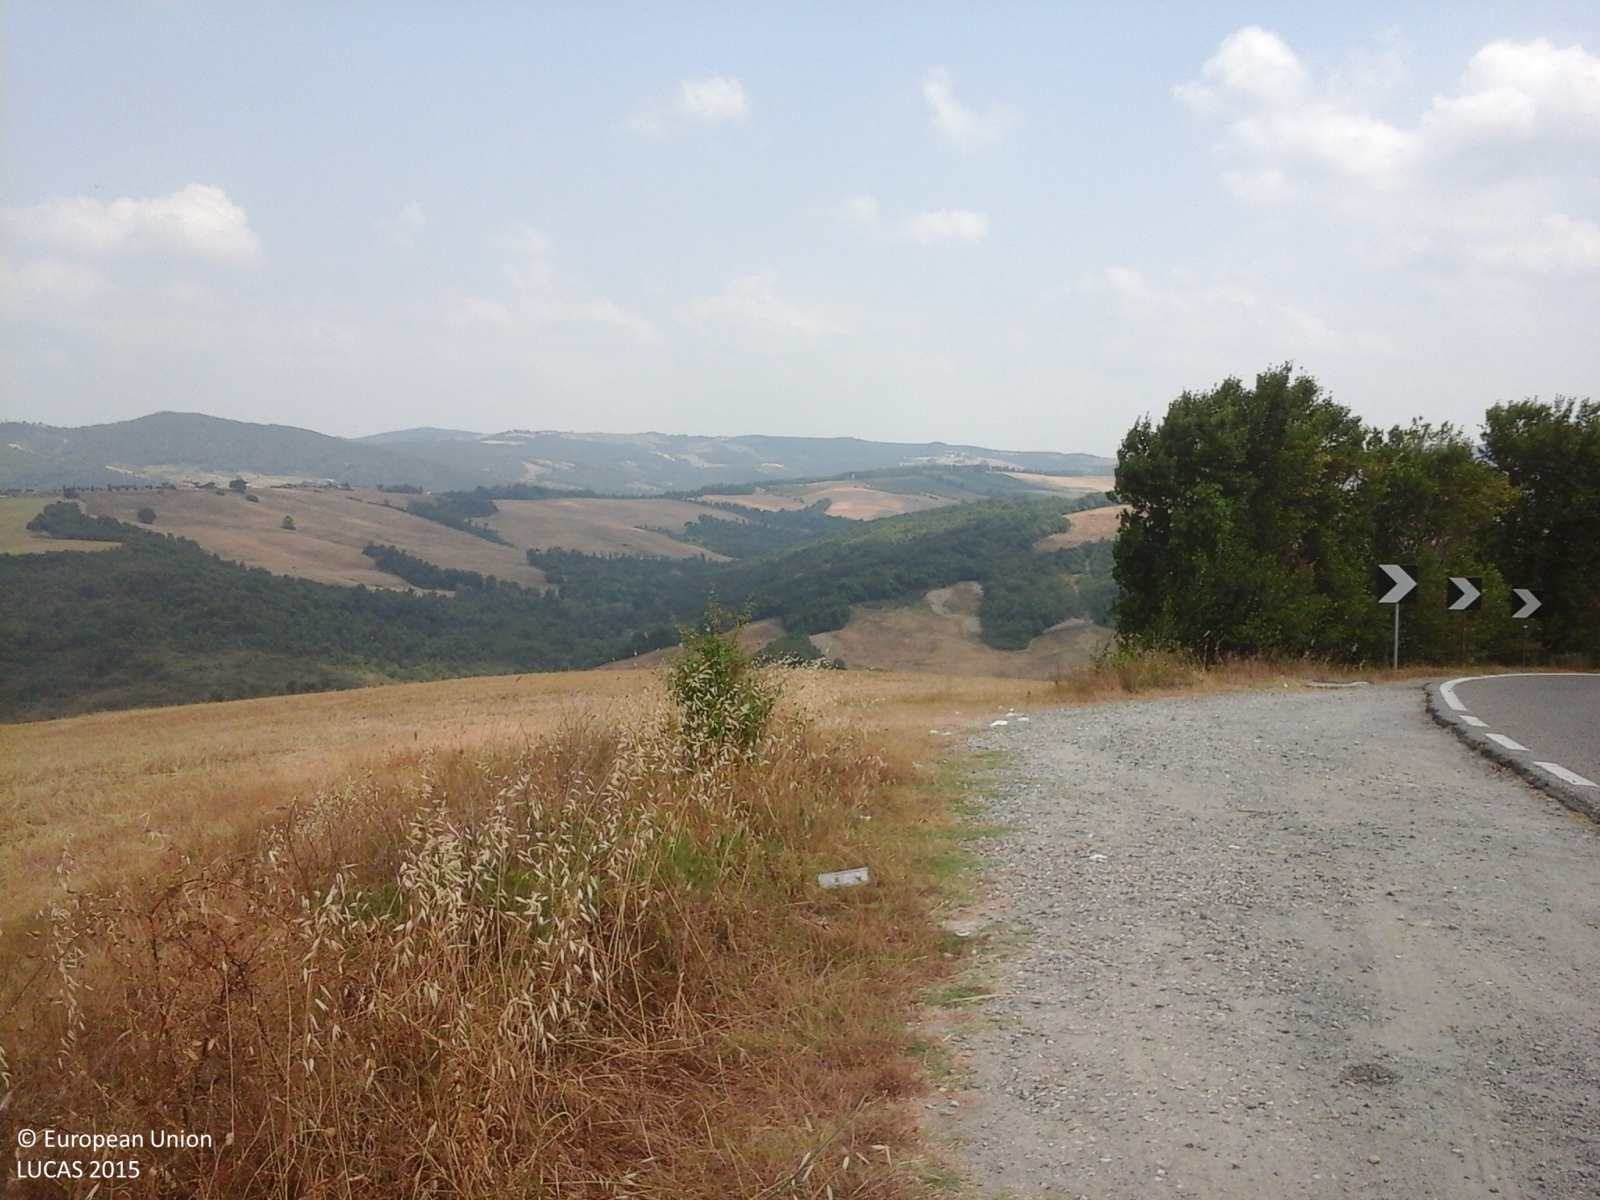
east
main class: Woodland
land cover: Broadleaved woodland
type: thermophilous deciduous forest
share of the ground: > 75 %
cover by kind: broadleaved forest trees 100 %
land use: Forestry
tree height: > 5 m
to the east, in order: Broadleaved woodland; Oats; Broadleaved woodland
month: July
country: IT
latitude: 43.3901
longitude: 10.9232
